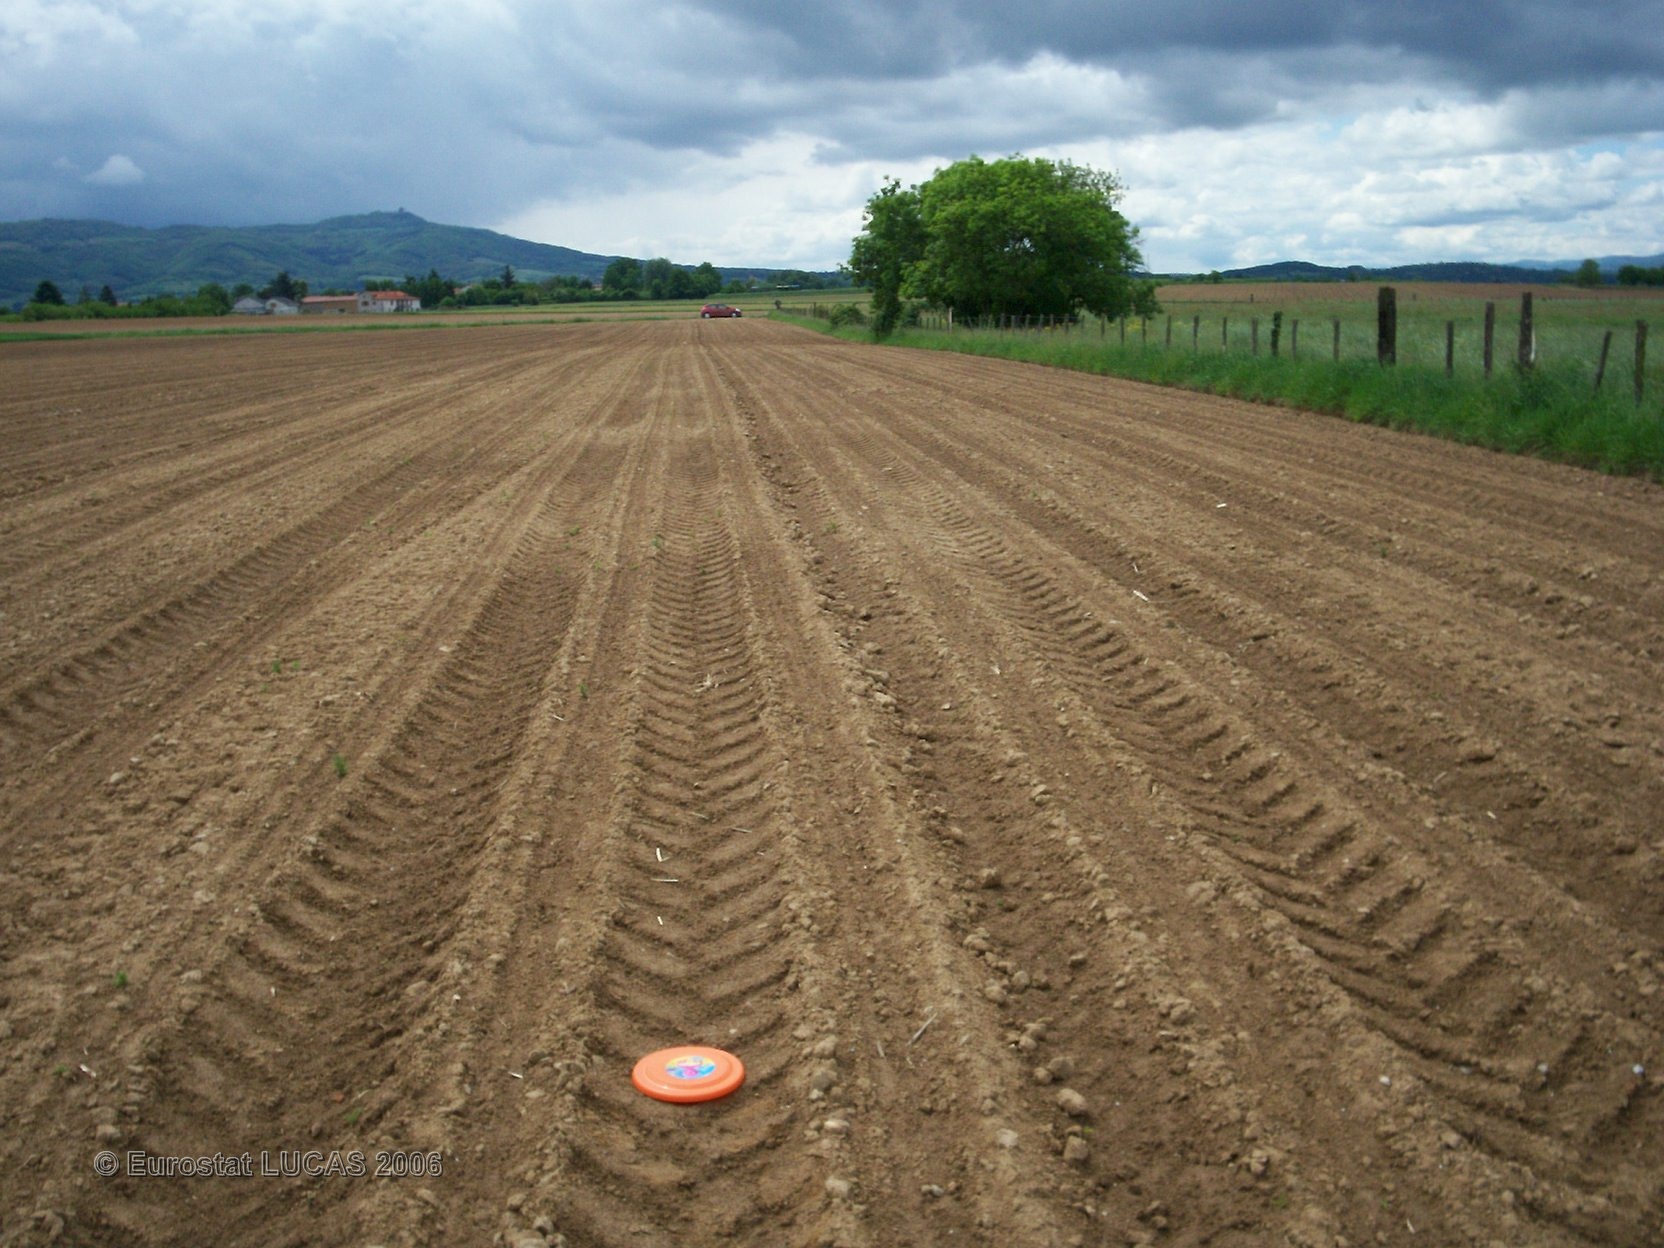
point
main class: Cropland
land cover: Maize
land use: Agriculture (excluding fallow land and kitchen gardens)
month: May
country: FR
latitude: 45.9157
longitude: 4.7557
